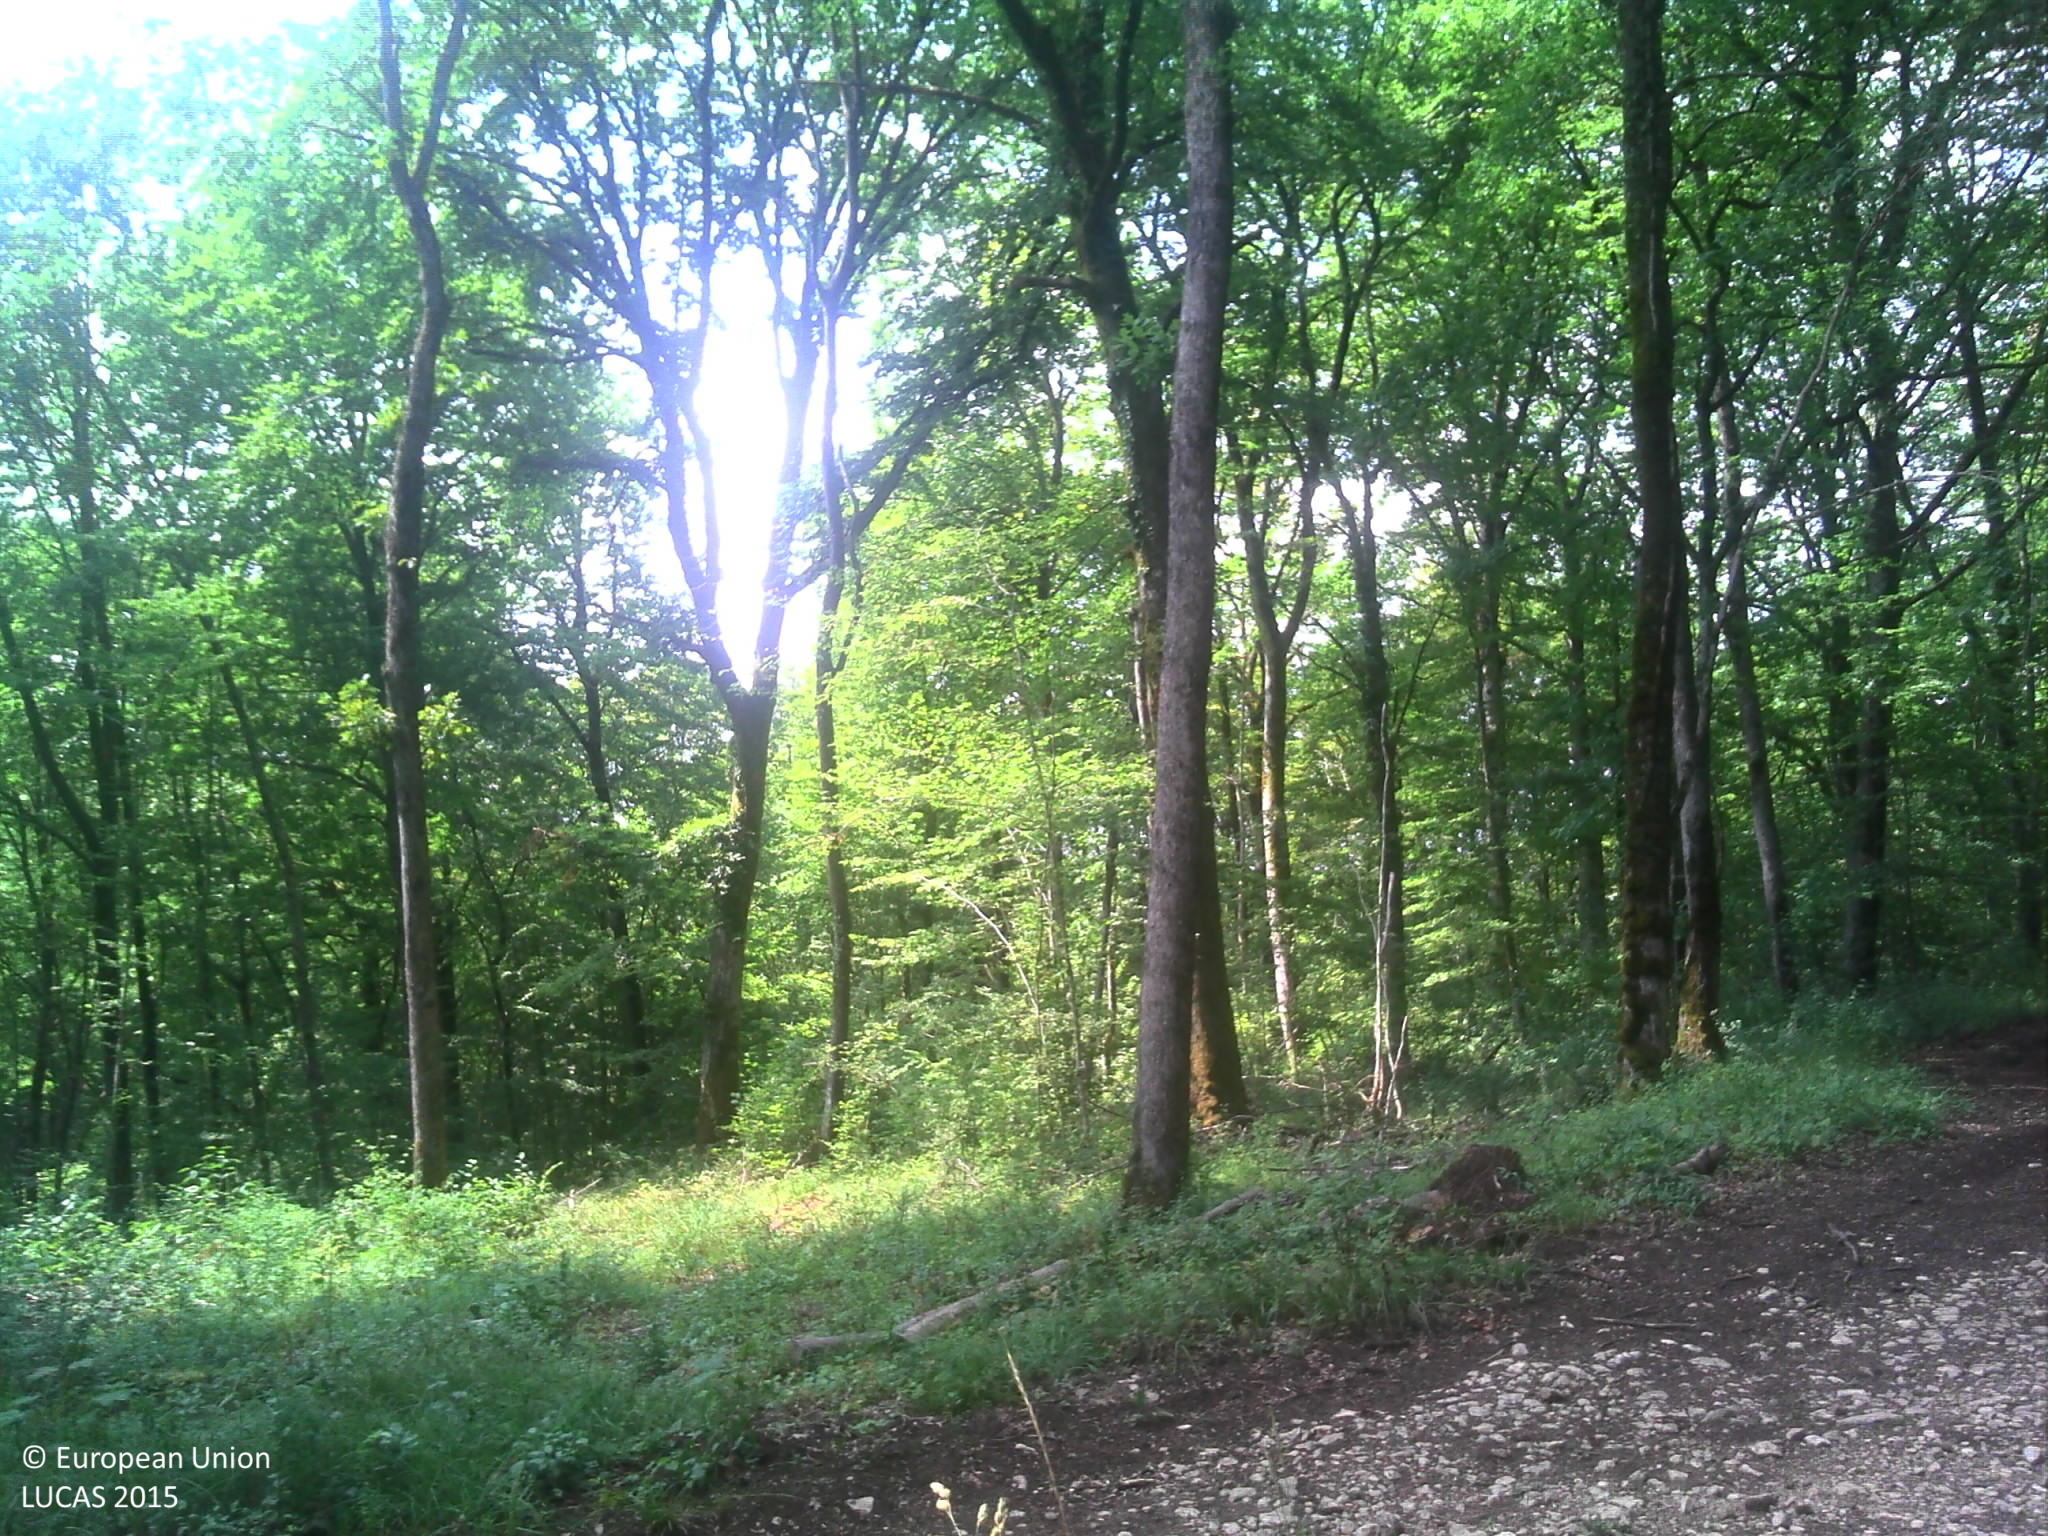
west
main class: Woodland
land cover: Broadleaved woodland
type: mesophytic deciduous forest
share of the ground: > 75 %
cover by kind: broadleaved forest trees 80 %, herbaceous plants 10 %, lichens and mosses 10 %
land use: Forestry
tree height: > 5 m
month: August
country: FR
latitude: 47.8093
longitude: 5.1257
